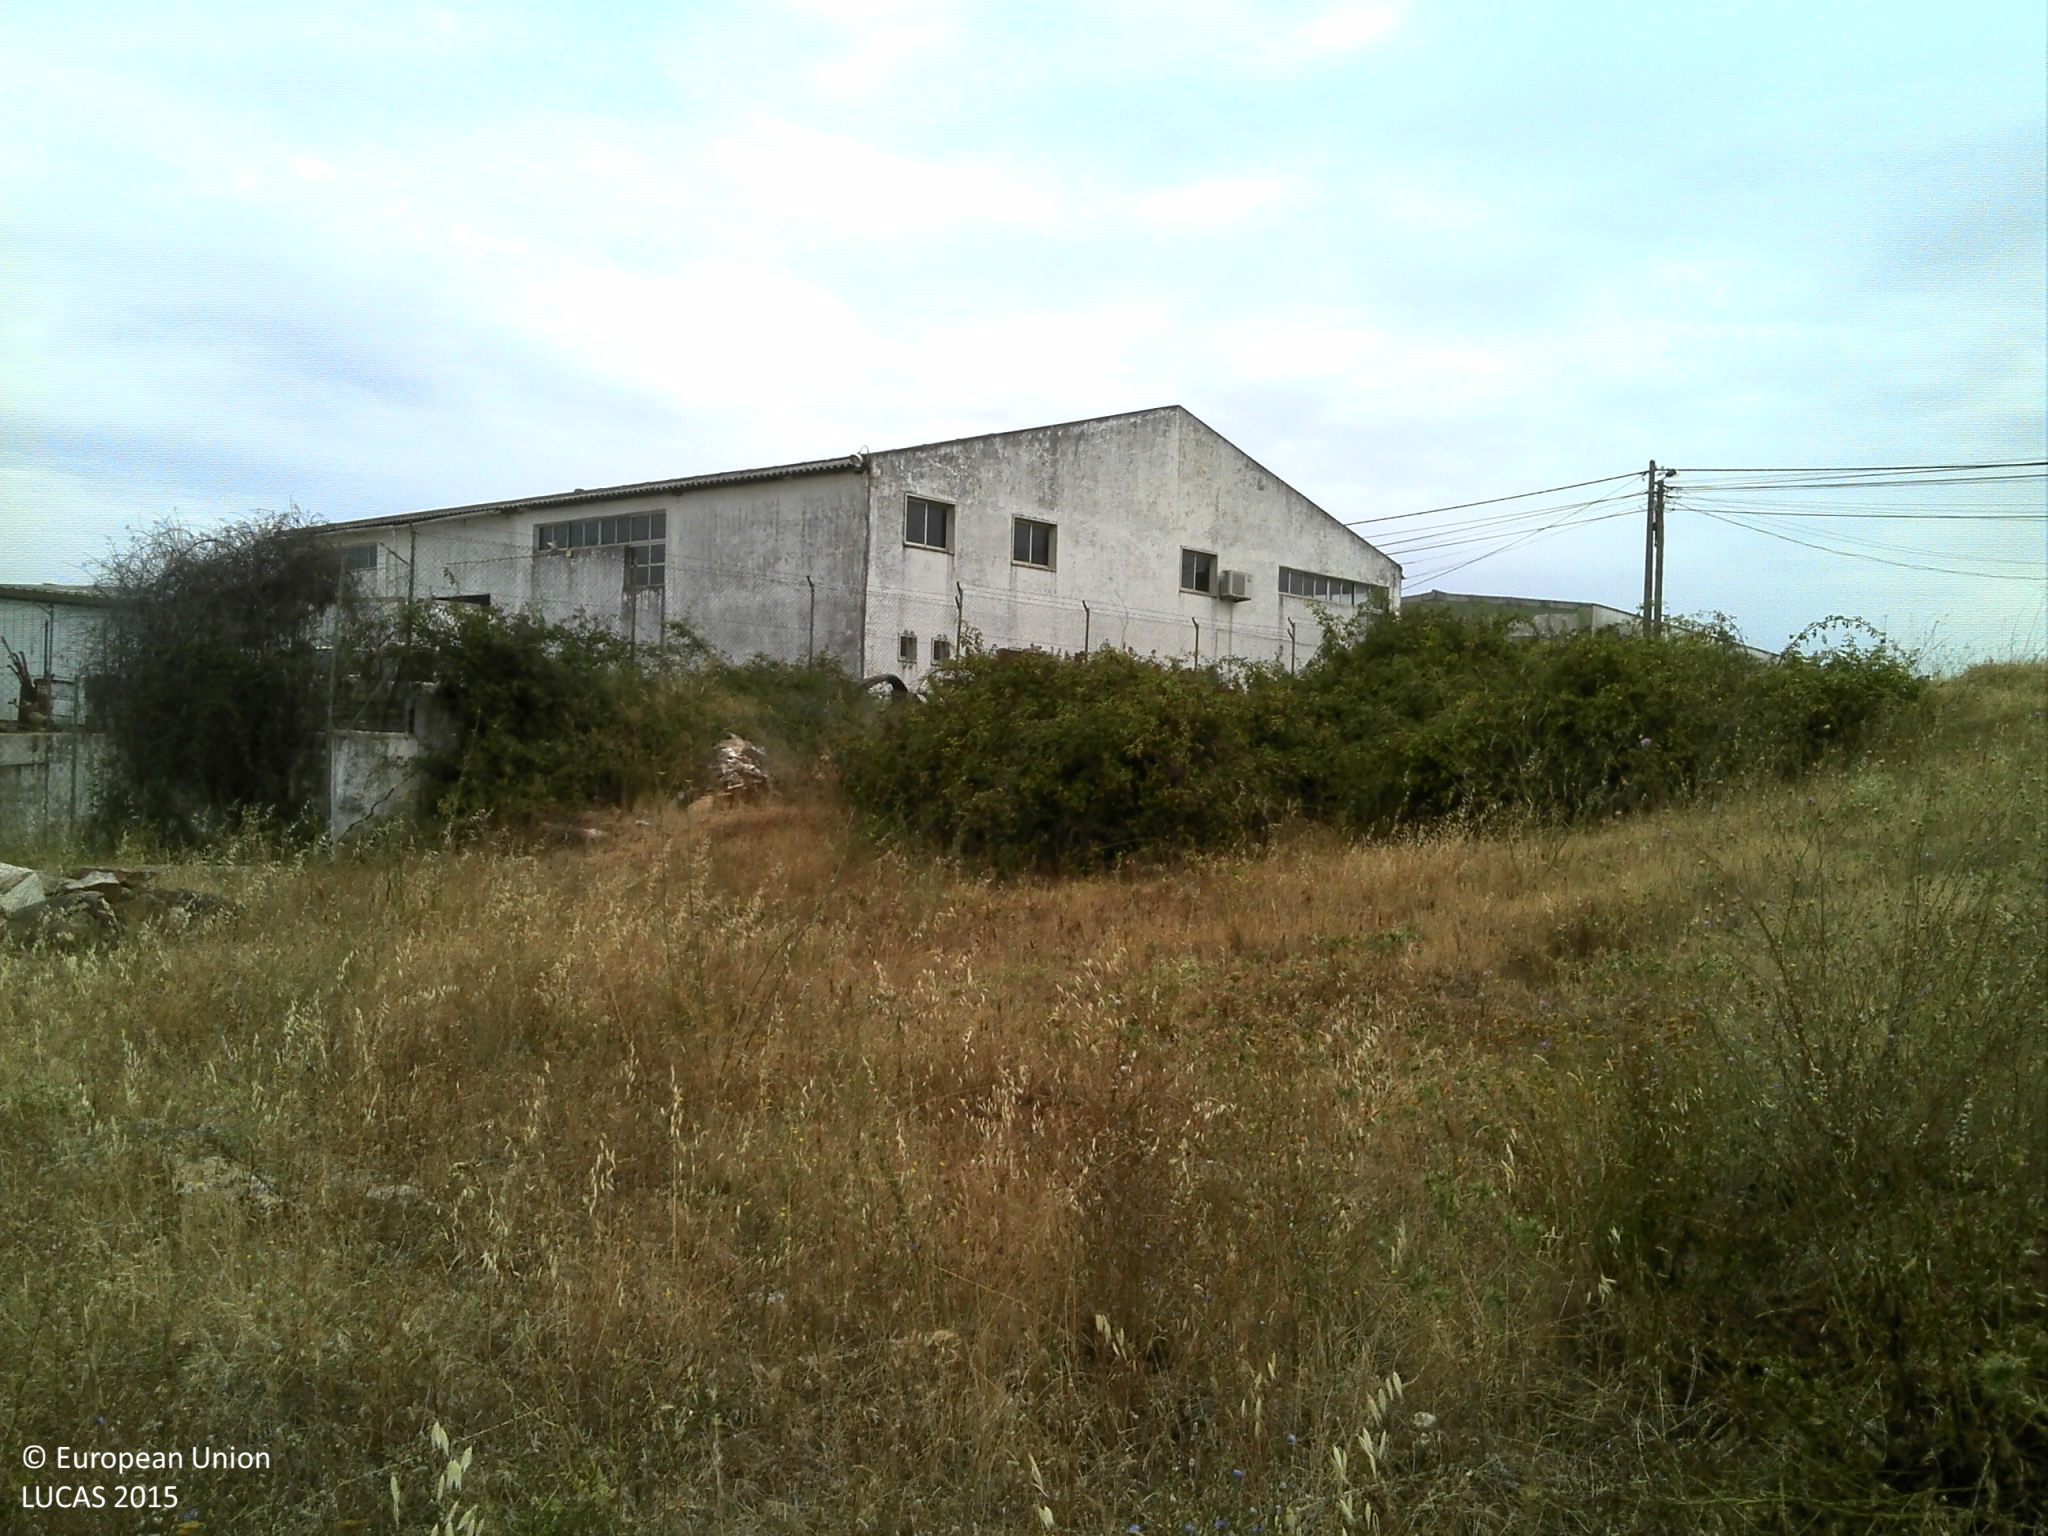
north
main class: Grassland
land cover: Spontaneously vegetated surfaces
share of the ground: > 75 %
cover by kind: herbaceous plants 90 %, unconsolidated bare surface 10 %
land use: Commerce
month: July
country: PT
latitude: 38.7998
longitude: -7.4542
